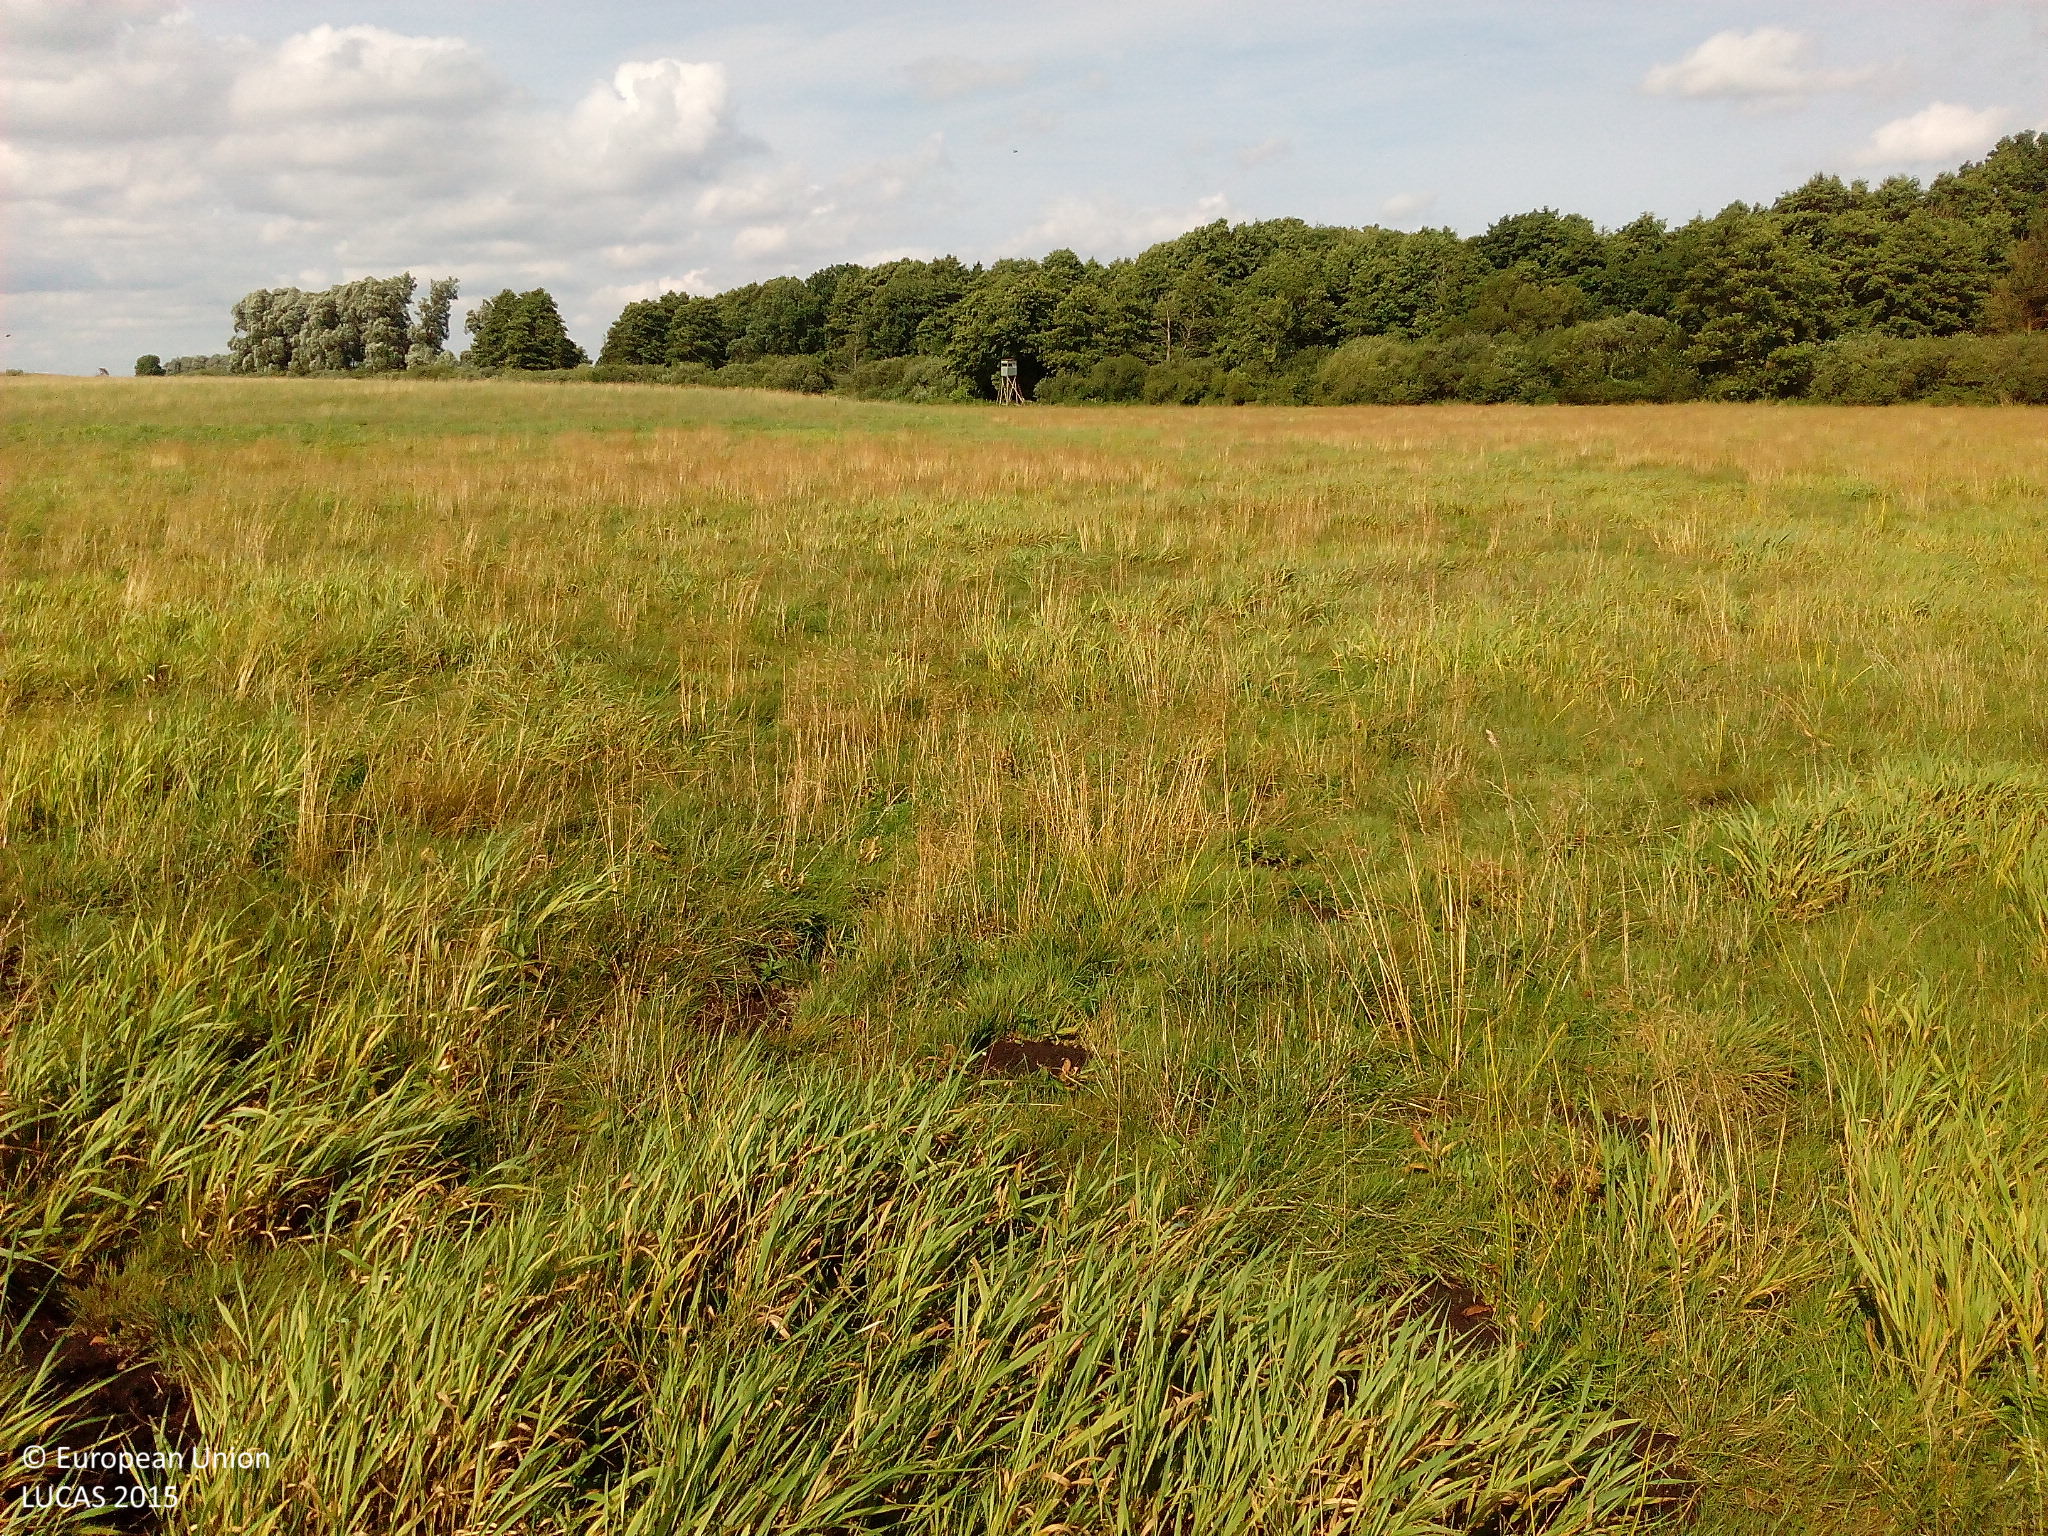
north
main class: Grassland
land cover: Grassland without tree/shrub cover
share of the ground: > 75 %
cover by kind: herbaceous plants 100 %
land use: Agriculture (excluding fallow land and kitchen gardens)
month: August
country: DE
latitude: 53.9295
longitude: 12.6949
